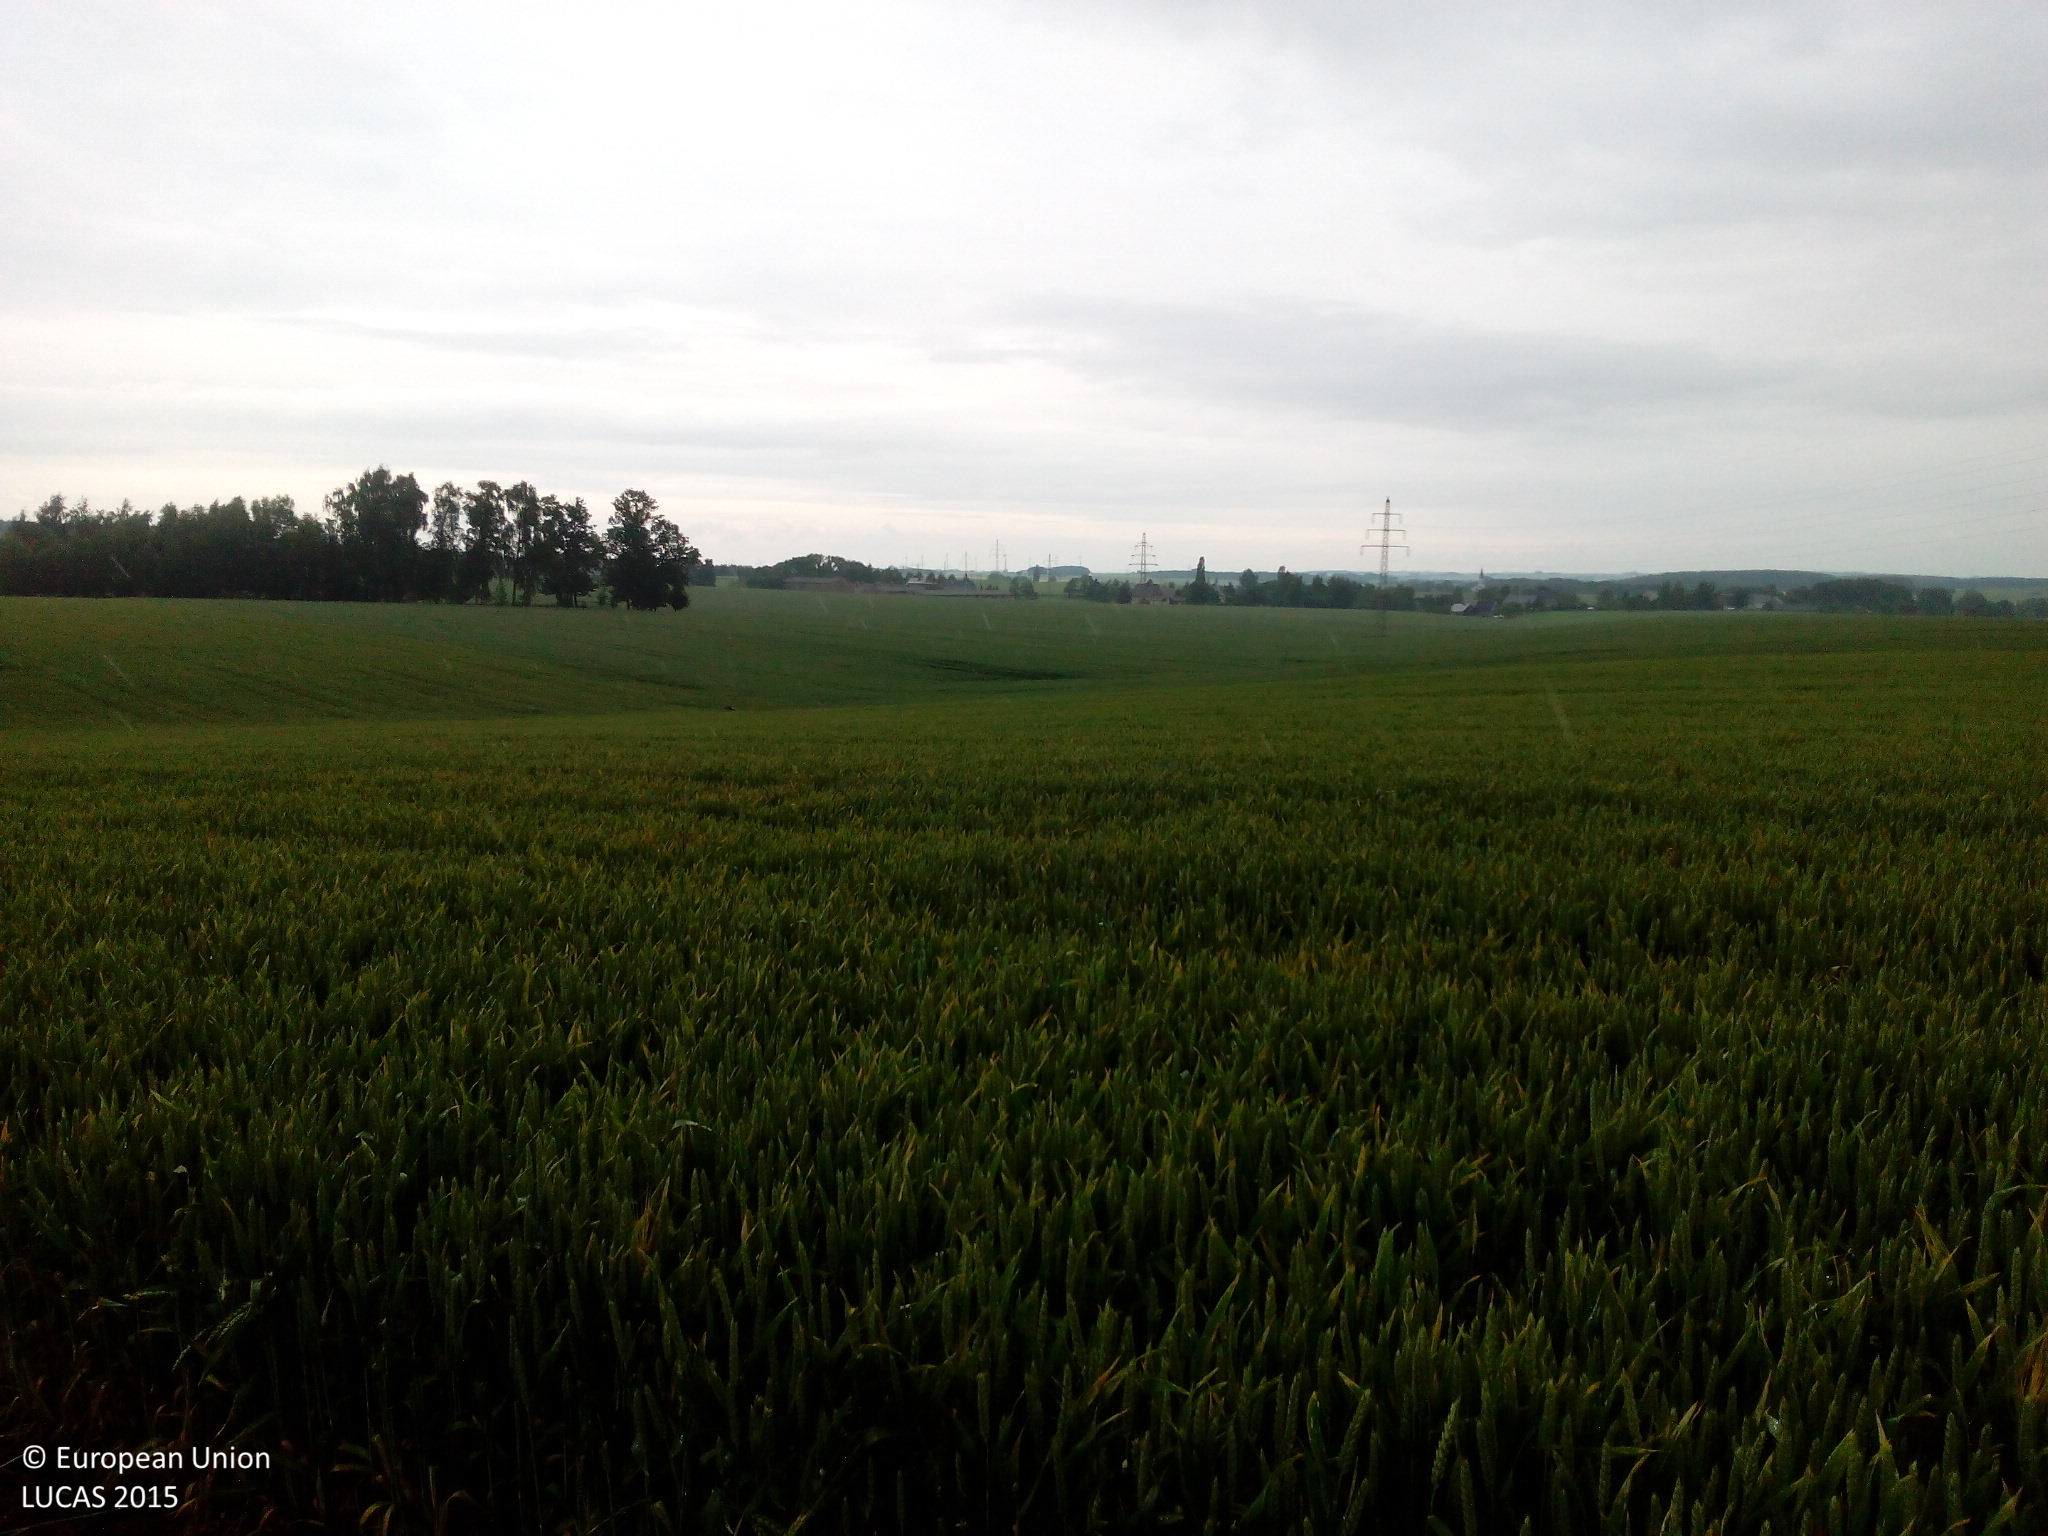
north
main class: Cropland
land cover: Common wheat
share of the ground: > 75 %
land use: Agriculture (excluding fallow land and kitchen gardens)
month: June
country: DE
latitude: 51.0060
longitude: 13.0927
